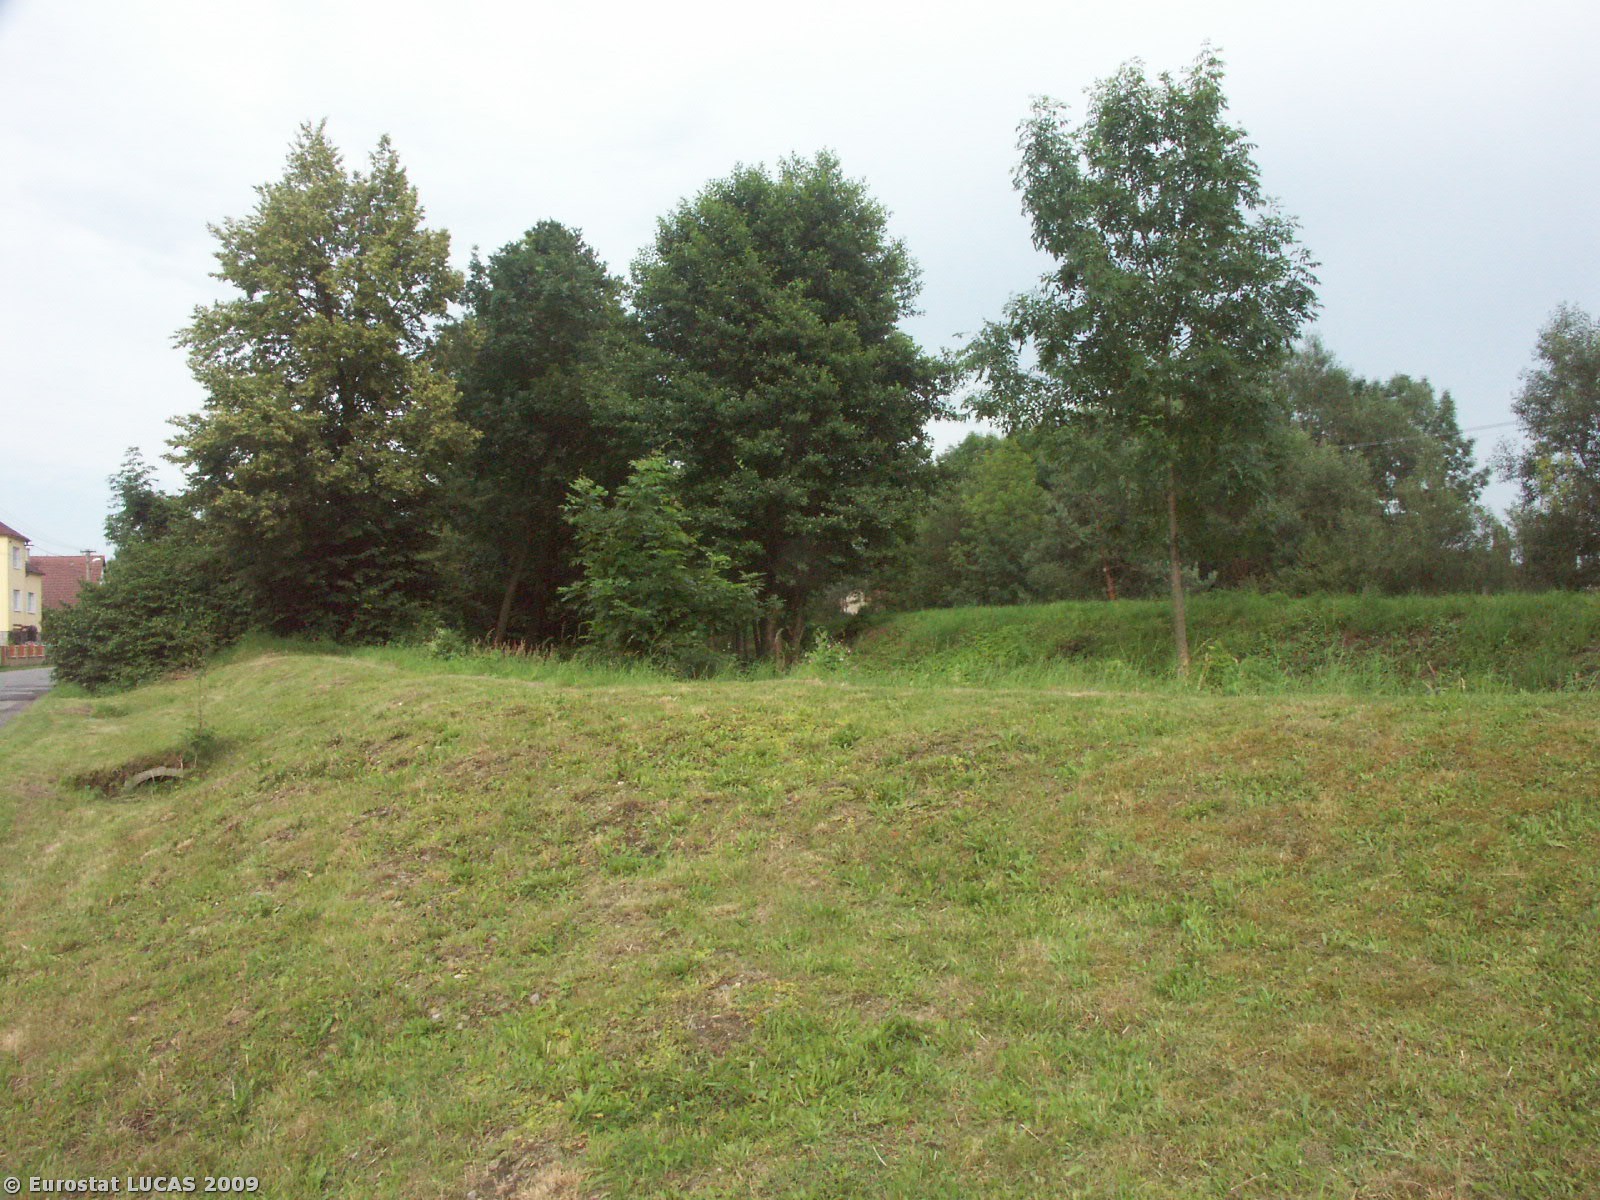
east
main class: Cropland
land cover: Apple fruit
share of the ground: 10 - 25 %
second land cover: Grassland with sparse tree/shrub cover
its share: > 75 %
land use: Kitchen garden
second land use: Protection infrastructures
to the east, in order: Apple fruit; Grassland with sparse tree/shrub cover; Artificial constructions; Inland running water; Broadleaved woodland; Artificial constructions; Broadleaved woodland; Electric lines; Tracks; Grassland without tree/shrub cover; Fences; Artificial constructions in urban areas
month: July
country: CZ
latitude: 49.8141
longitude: 17.1677
